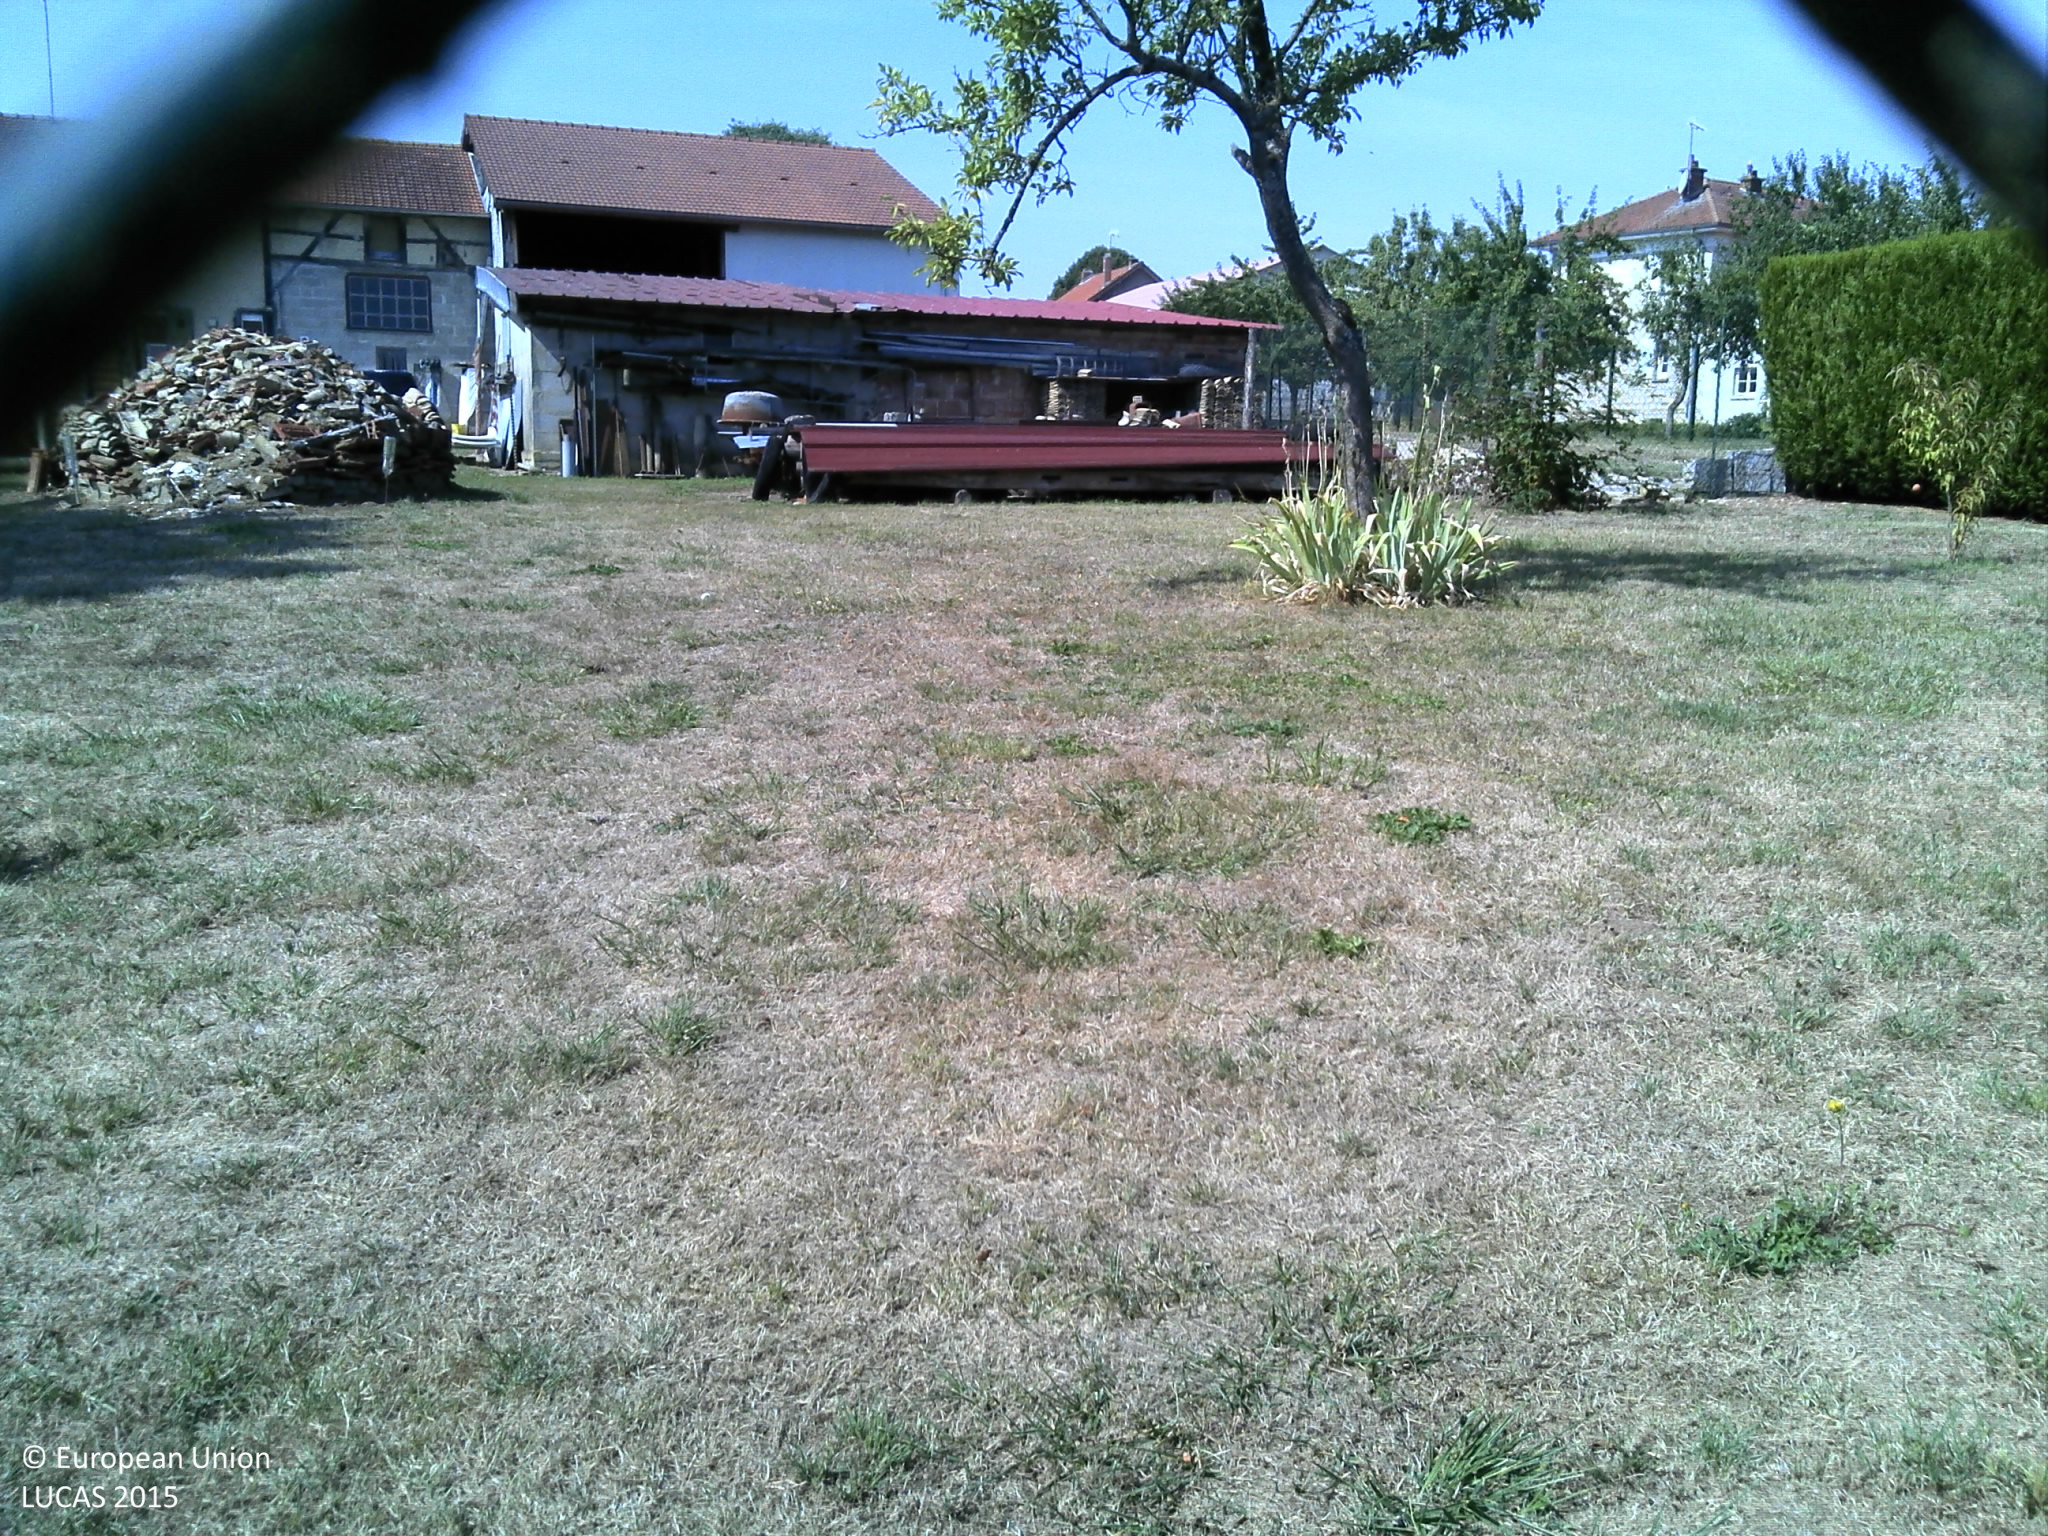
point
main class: Grassland
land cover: Grassland with sparse tree/shrub cover
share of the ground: > 75 %
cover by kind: herbaceous plants 90 %, broadleaved forest trees 5 %, shrubs 5 %
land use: Residential
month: August
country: FR
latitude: 48.9518
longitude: 4.8768
